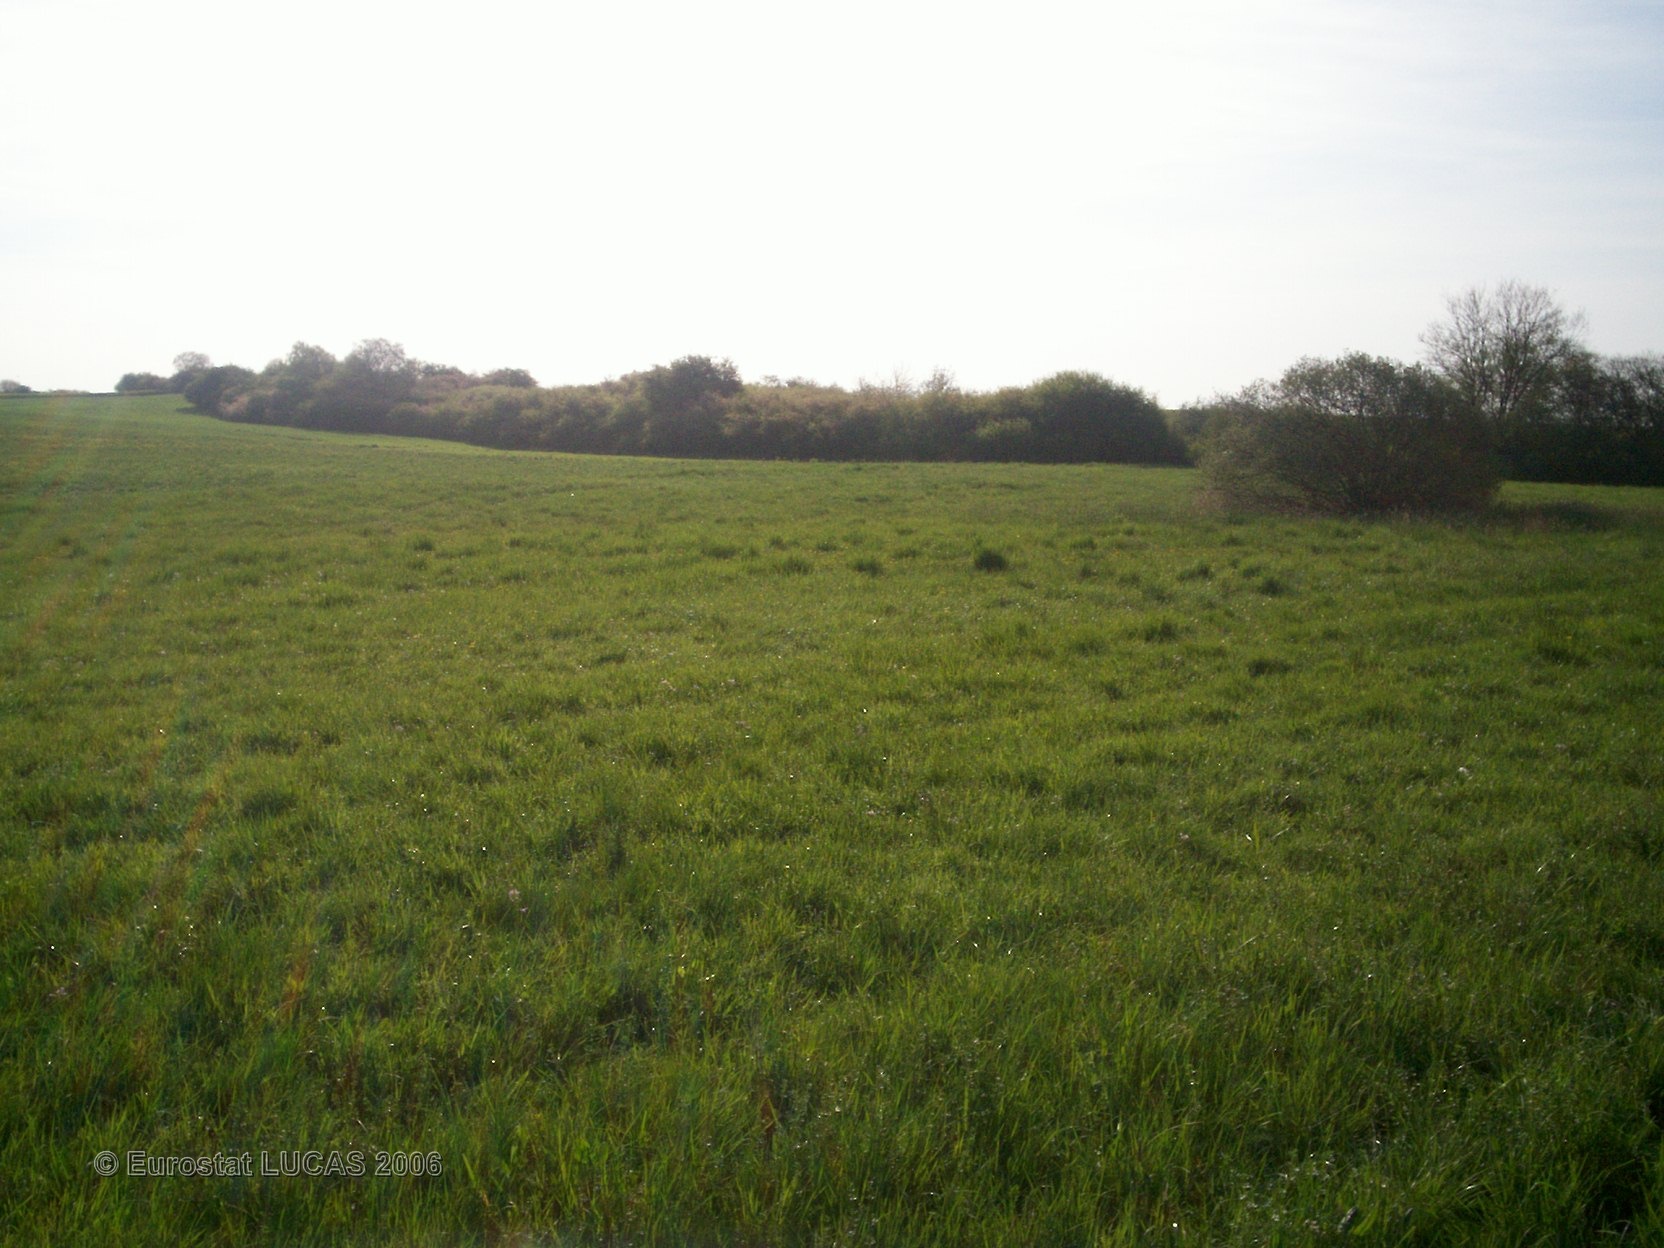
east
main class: Grassland
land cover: Grassland without tree/shrub cover
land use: Agriculture (excluding fallow land and kitchen gardens)
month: May
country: FR
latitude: 48.9909
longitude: 6.9255
